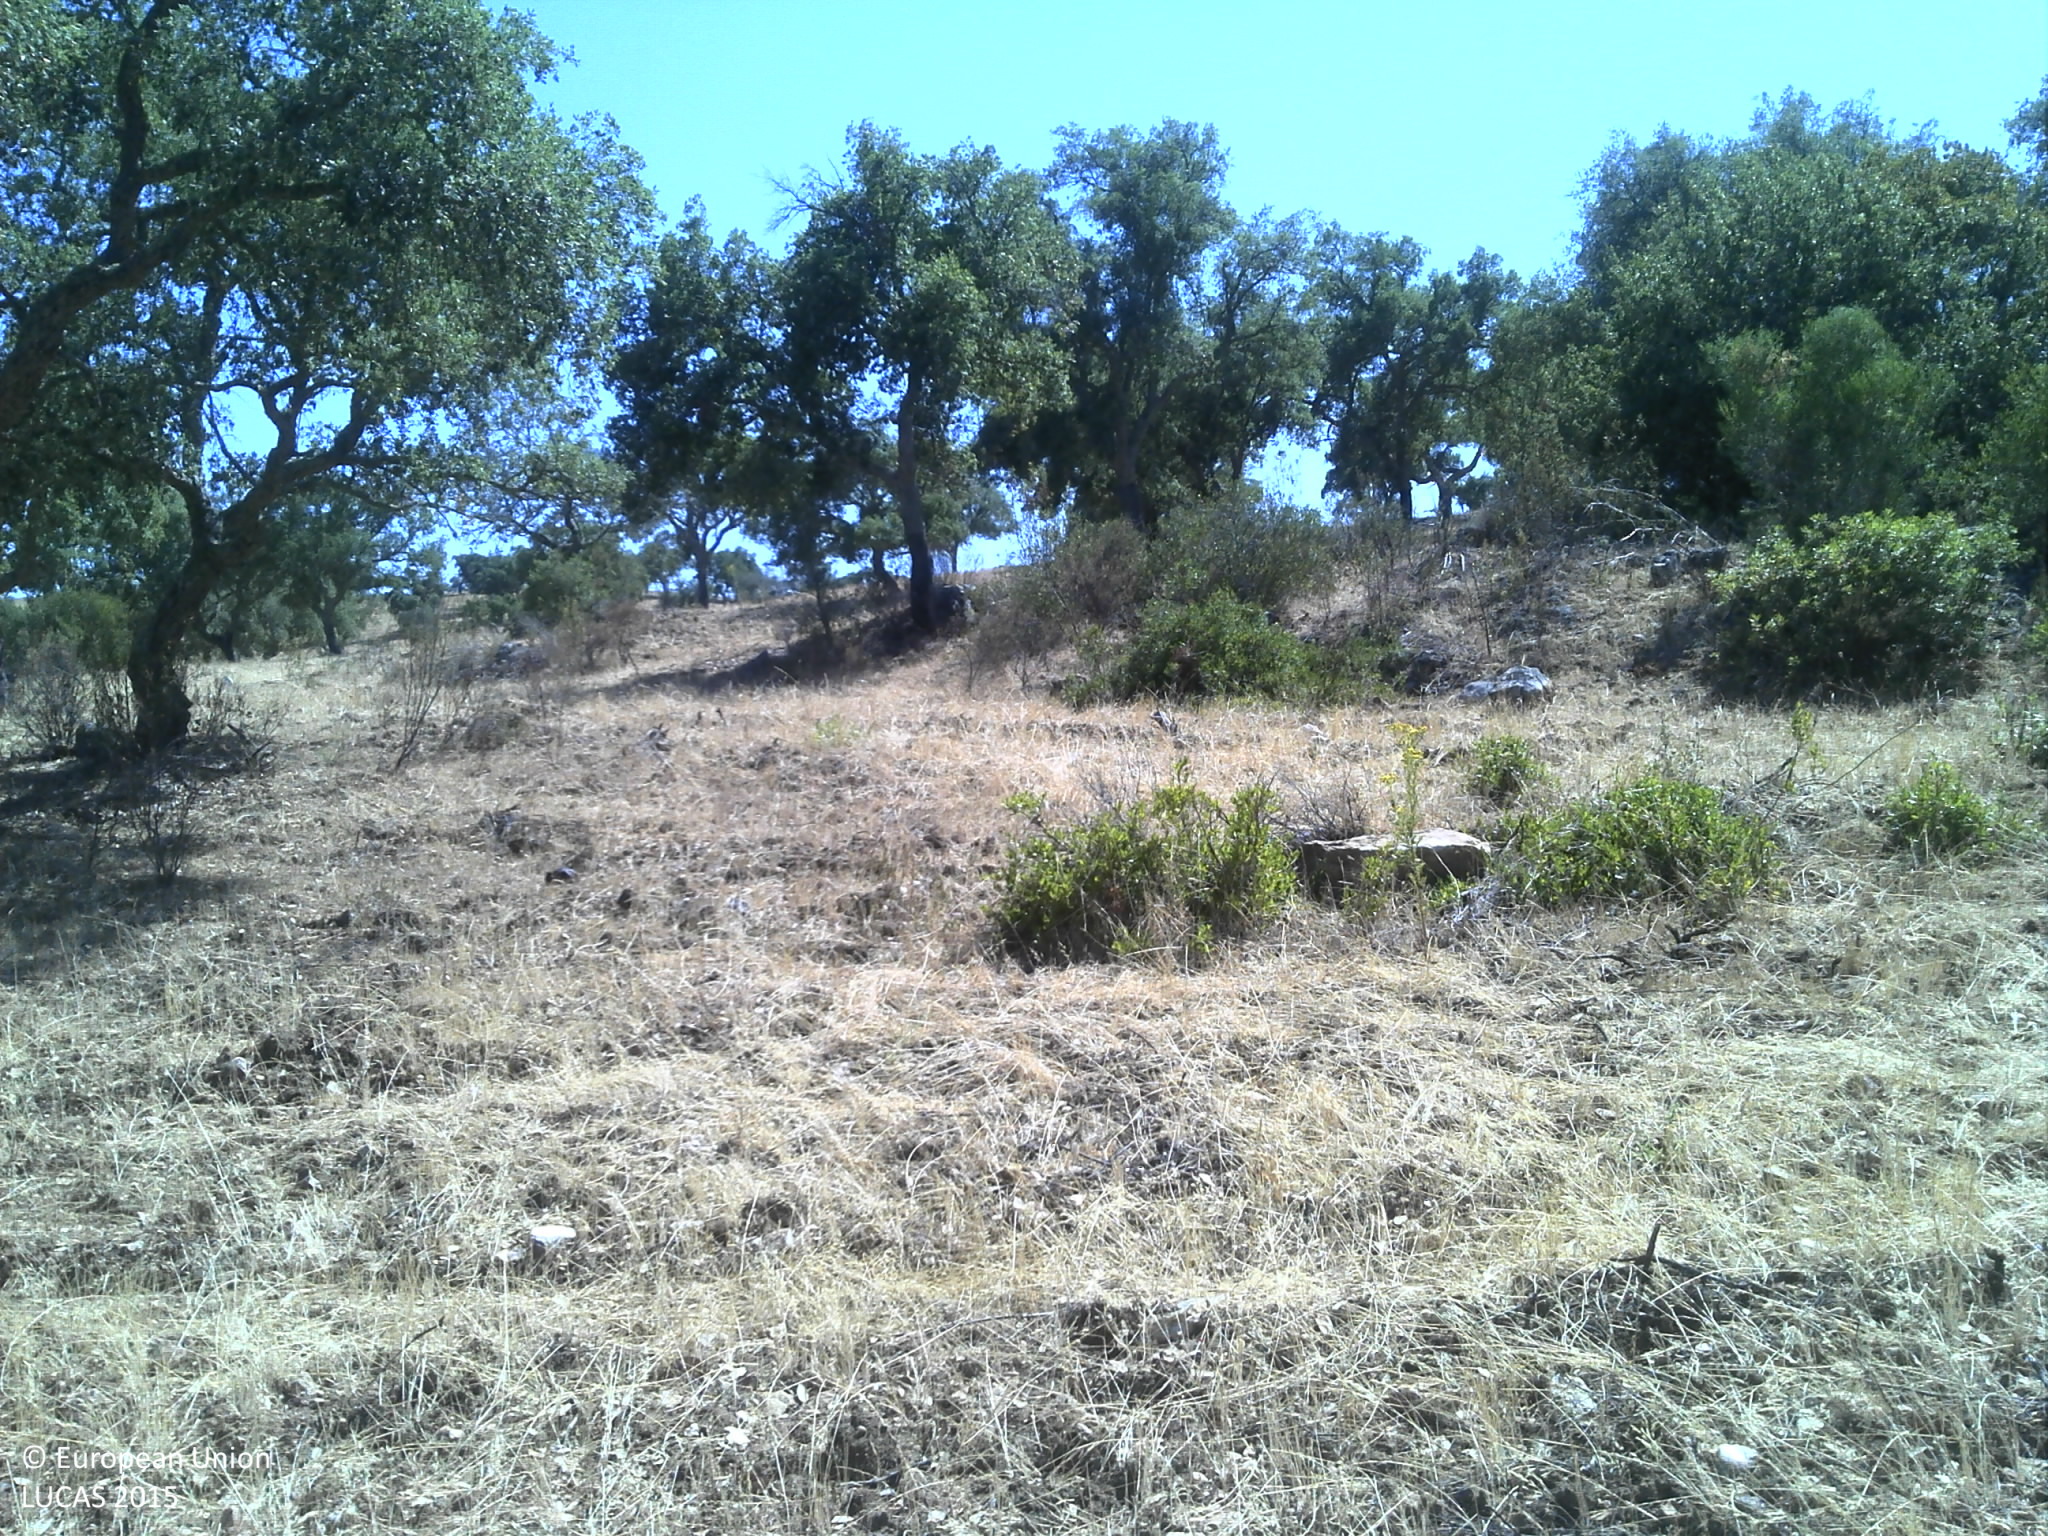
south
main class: Woodland
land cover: Broadleaved woodland
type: broadleaved evergreen forest
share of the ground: 25 - 50 %
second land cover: Grassland without tree/shrub cover
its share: 25 - 50 %
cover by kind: broadleaved forest trees 40 %, unconsolidated bare surface 35 %, herbaceous plants 25 %
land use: Forestry
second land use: Agriculture (excluding fallow land and kitchen gardens)
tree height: > 5 m
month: July
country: PT
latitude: 38.9939
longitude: -8.1930
